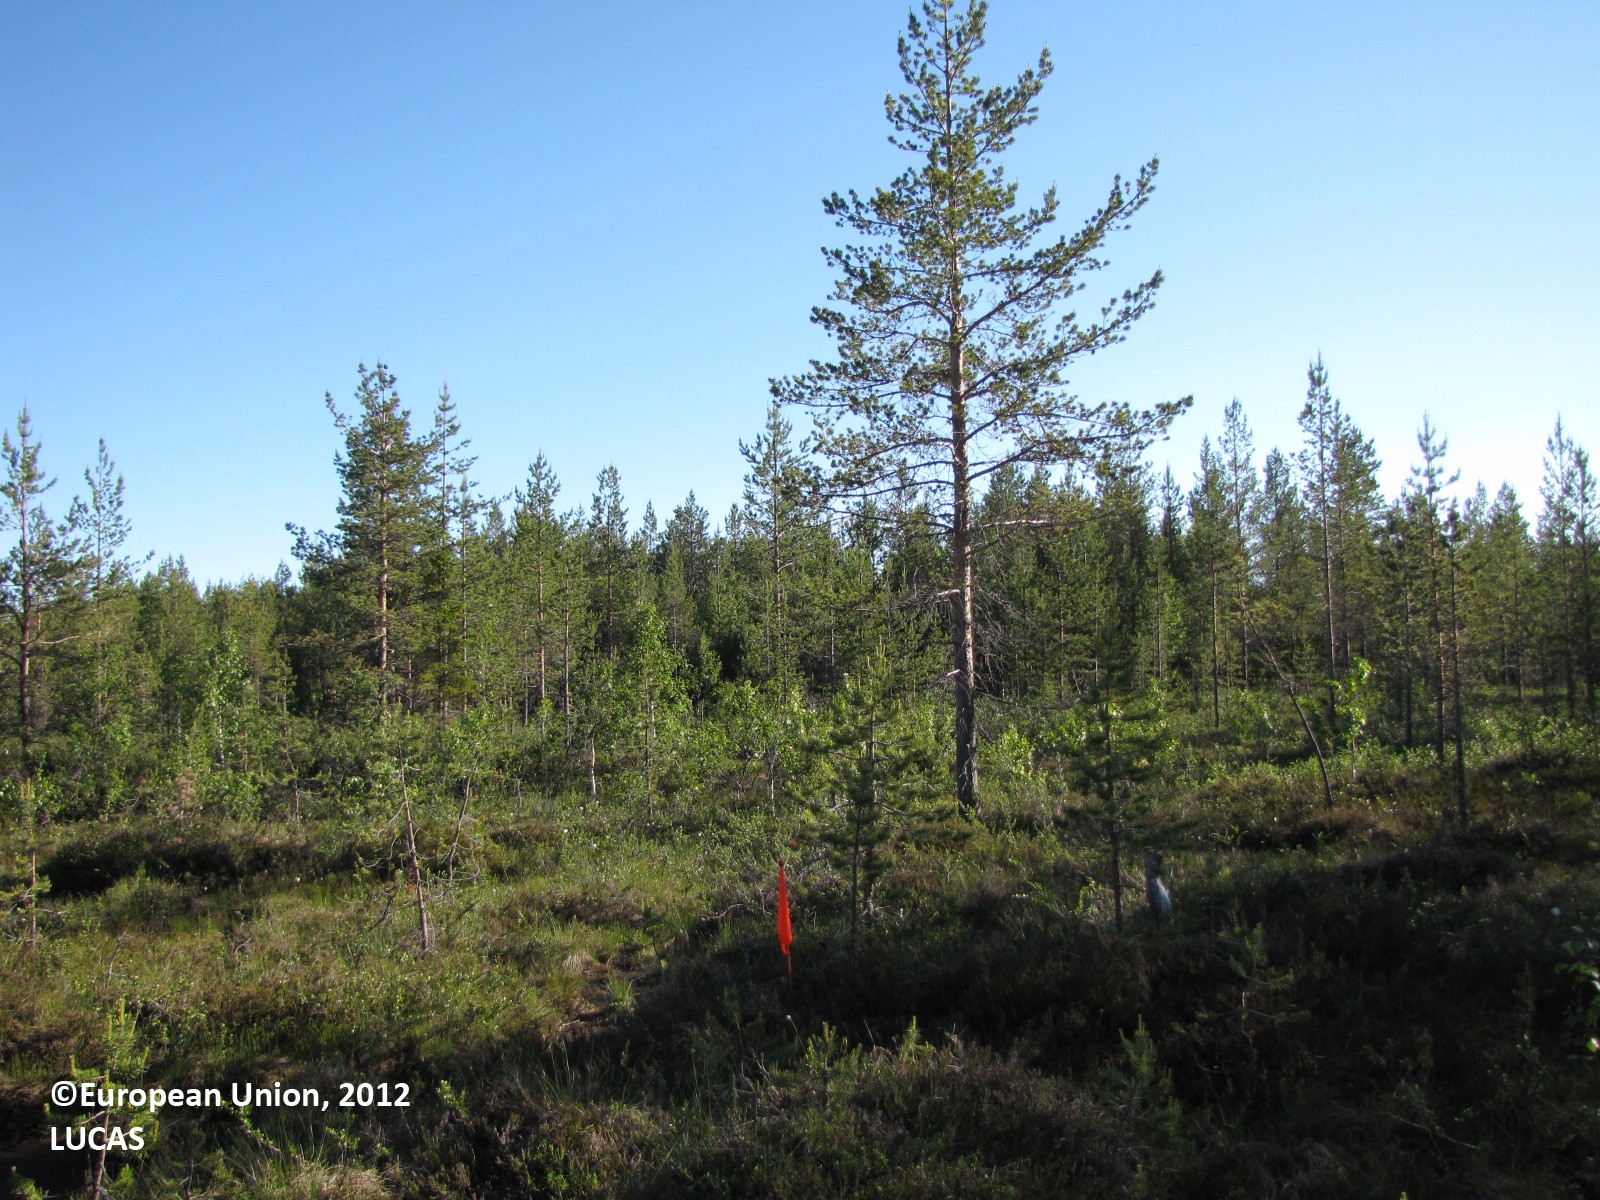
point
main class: Woodland
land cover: Pine dominated coniferous woodland
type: boreal forest
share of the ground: 10 - 25 %
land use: Forestry
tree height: > 5 m
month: July
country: FI
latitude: 66.4246
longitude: 24.6801
